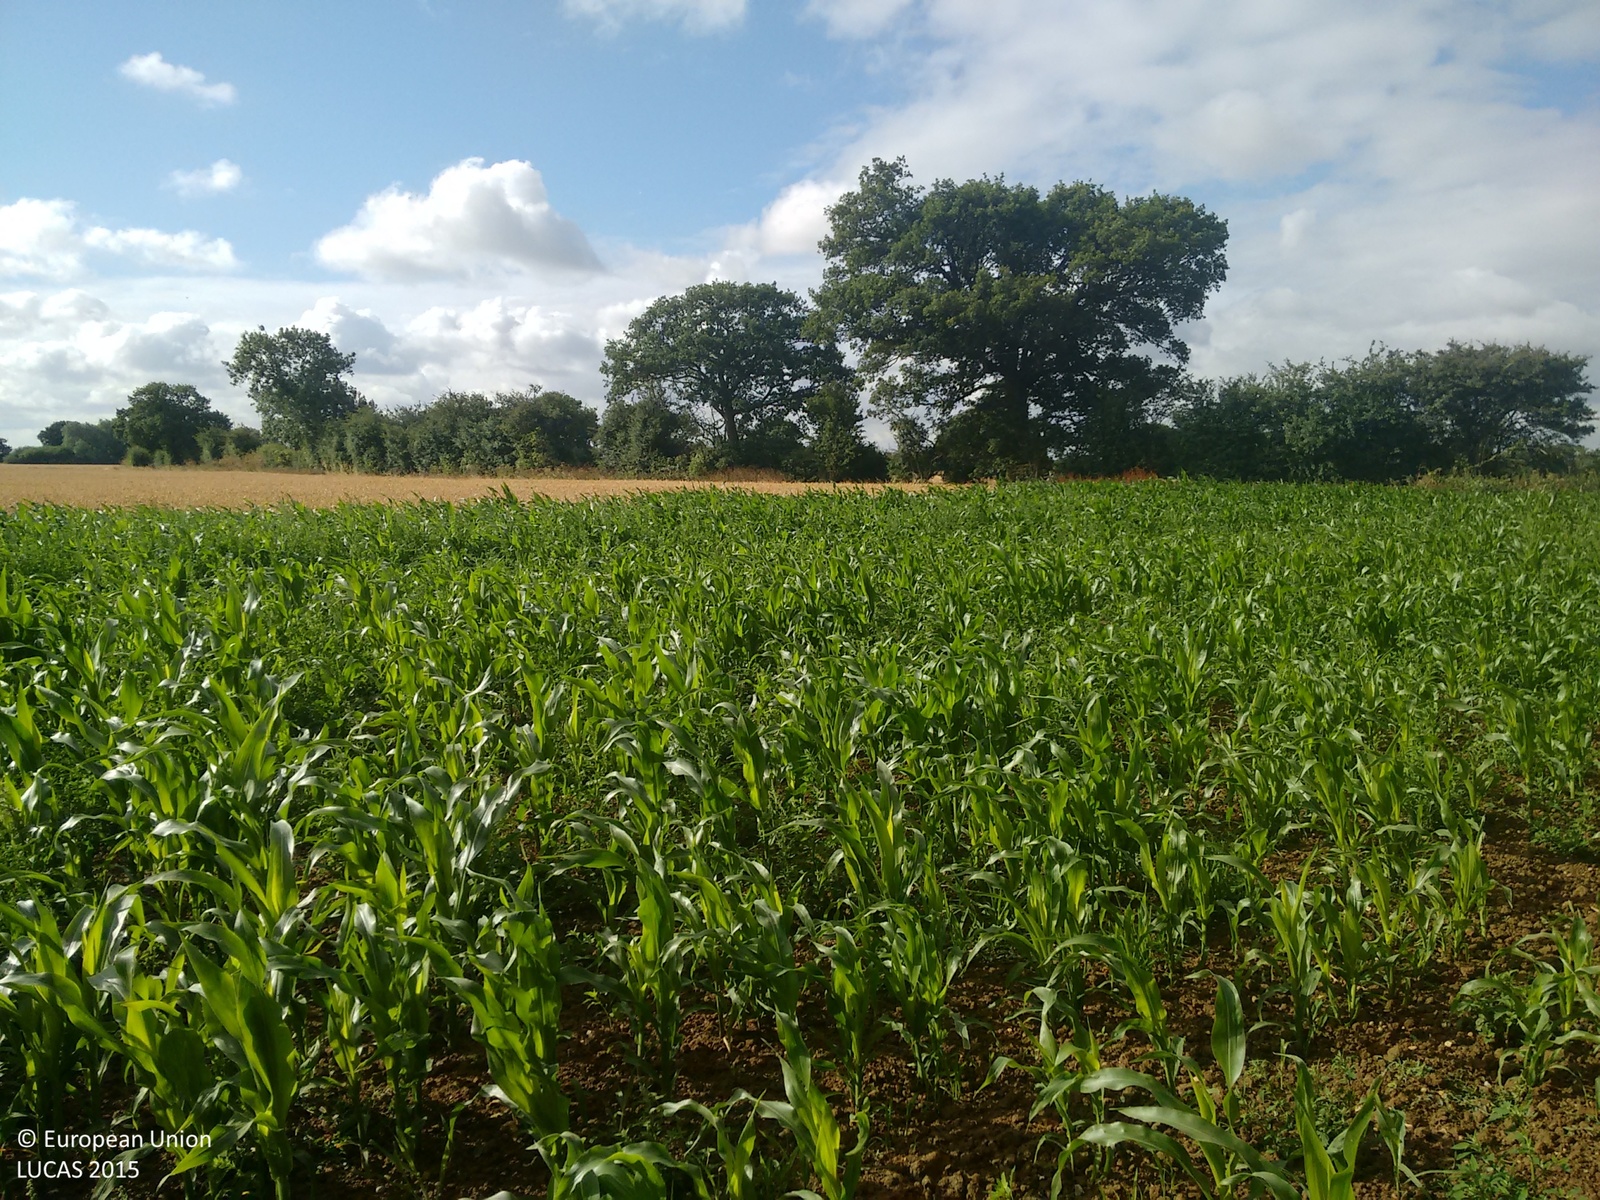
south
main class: Cropland
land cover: Maize
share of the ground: > 75 %
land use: Agriculture (excluding fallow land and kitchen gardens)
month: July
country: GB
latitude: 51.6792
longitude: 0.6160
